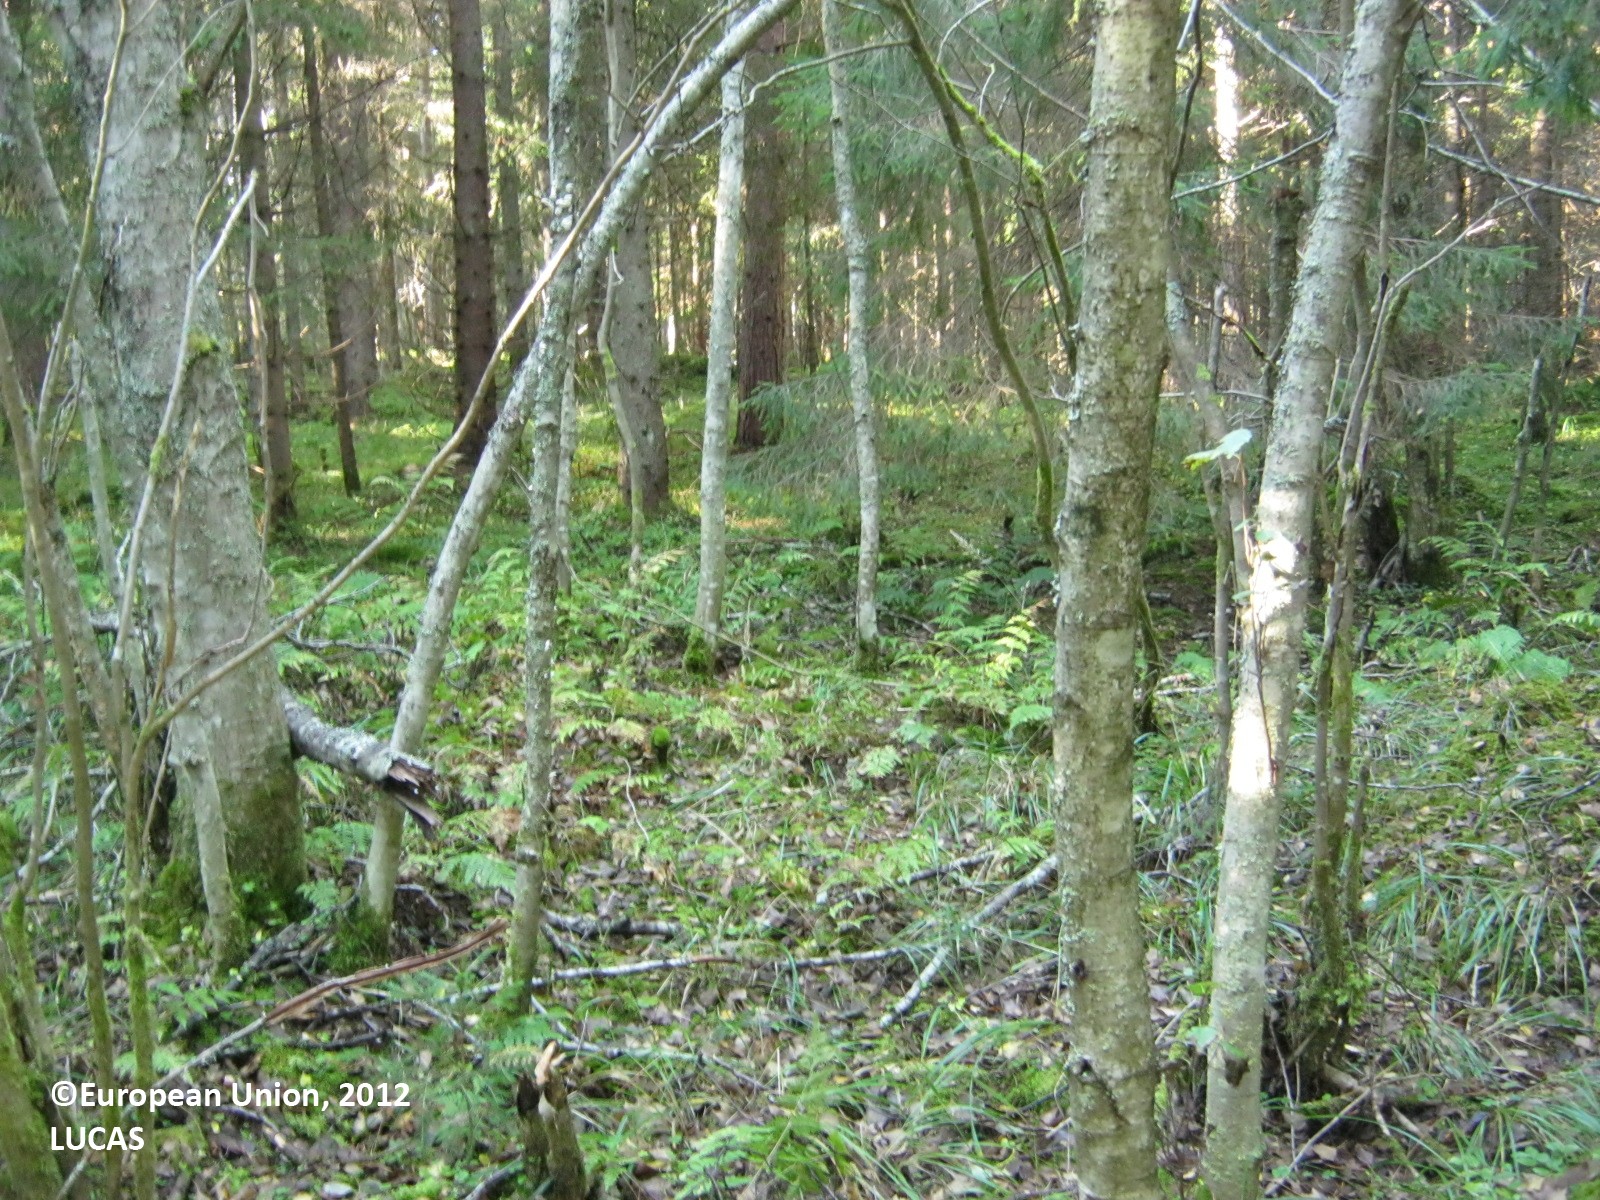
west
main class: Woodland
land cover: Spruce dominated mixed woodland
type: boreal forest
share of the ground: 50 - 75 %
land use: Forestry
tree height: > 5 m
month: September
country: FI
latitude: 62.5227
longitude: 27.7972
